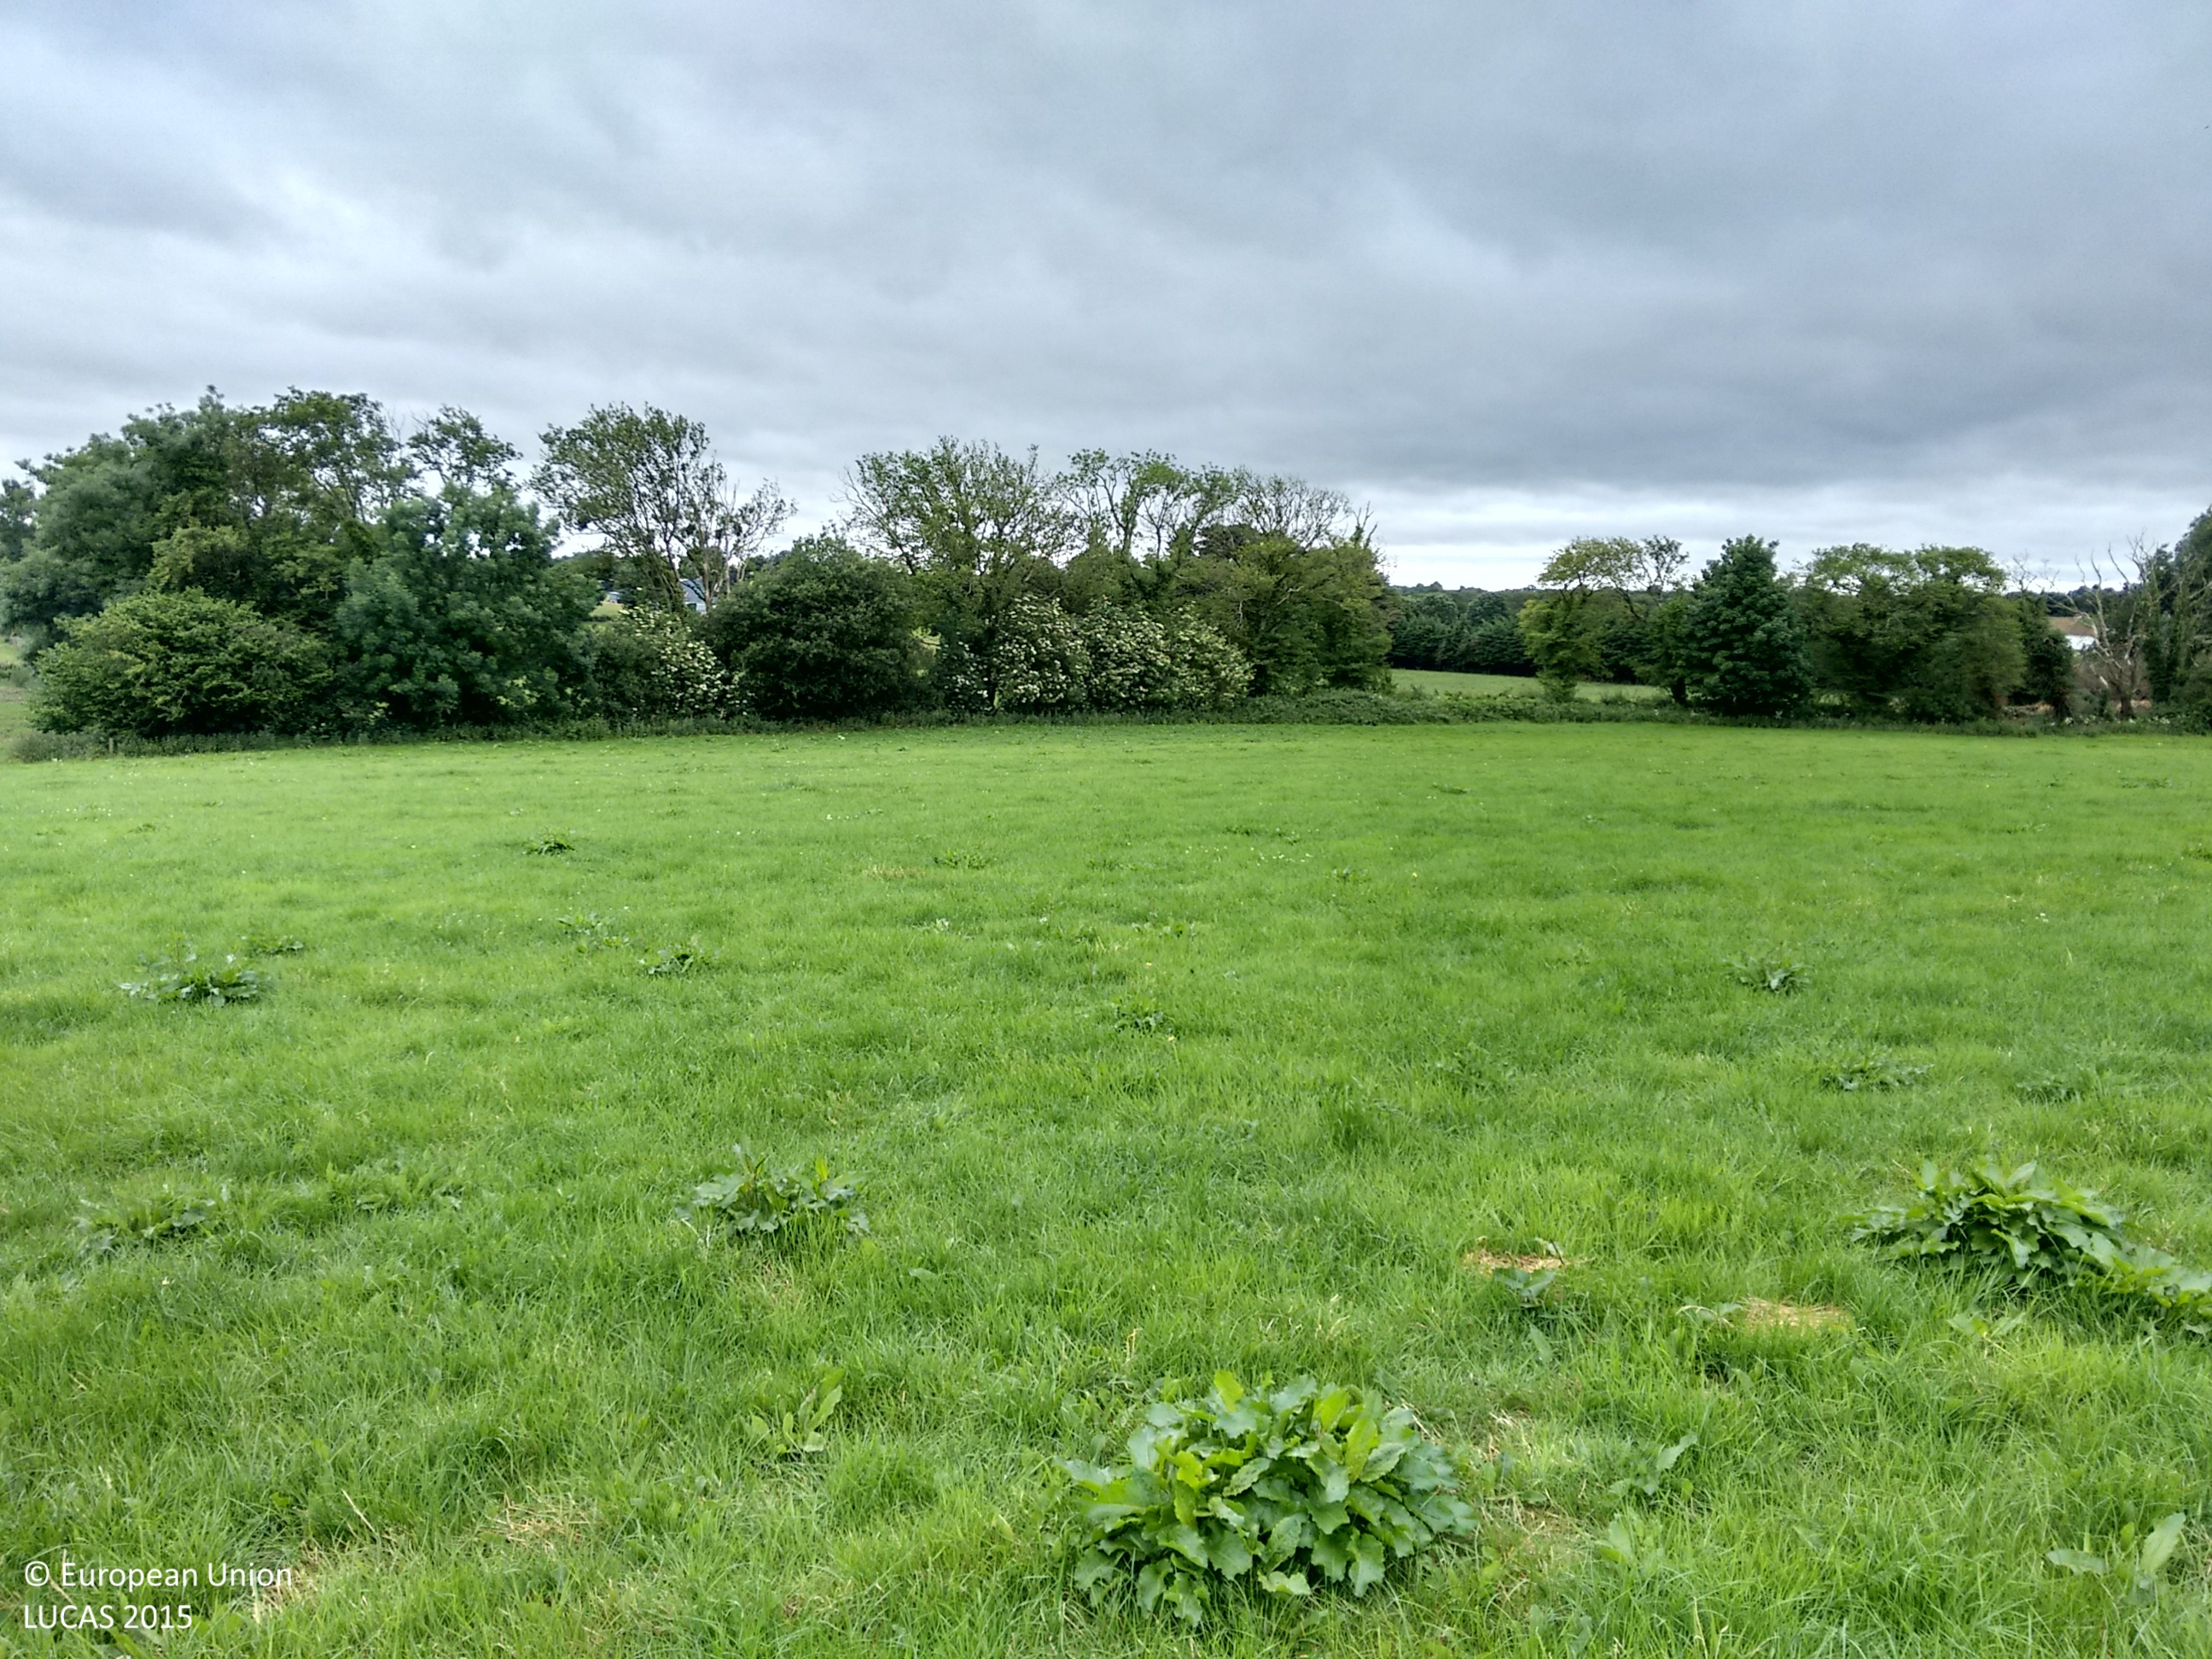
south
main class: Grassland
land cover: Grassland without tree/shrub cover
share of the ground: > 75 %
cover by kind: herbaceous plants 100 %
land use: Agriculture (excluding fallow land and kitchen gardens)
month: July
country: IE
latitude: 53.5138
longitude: -6.9861
